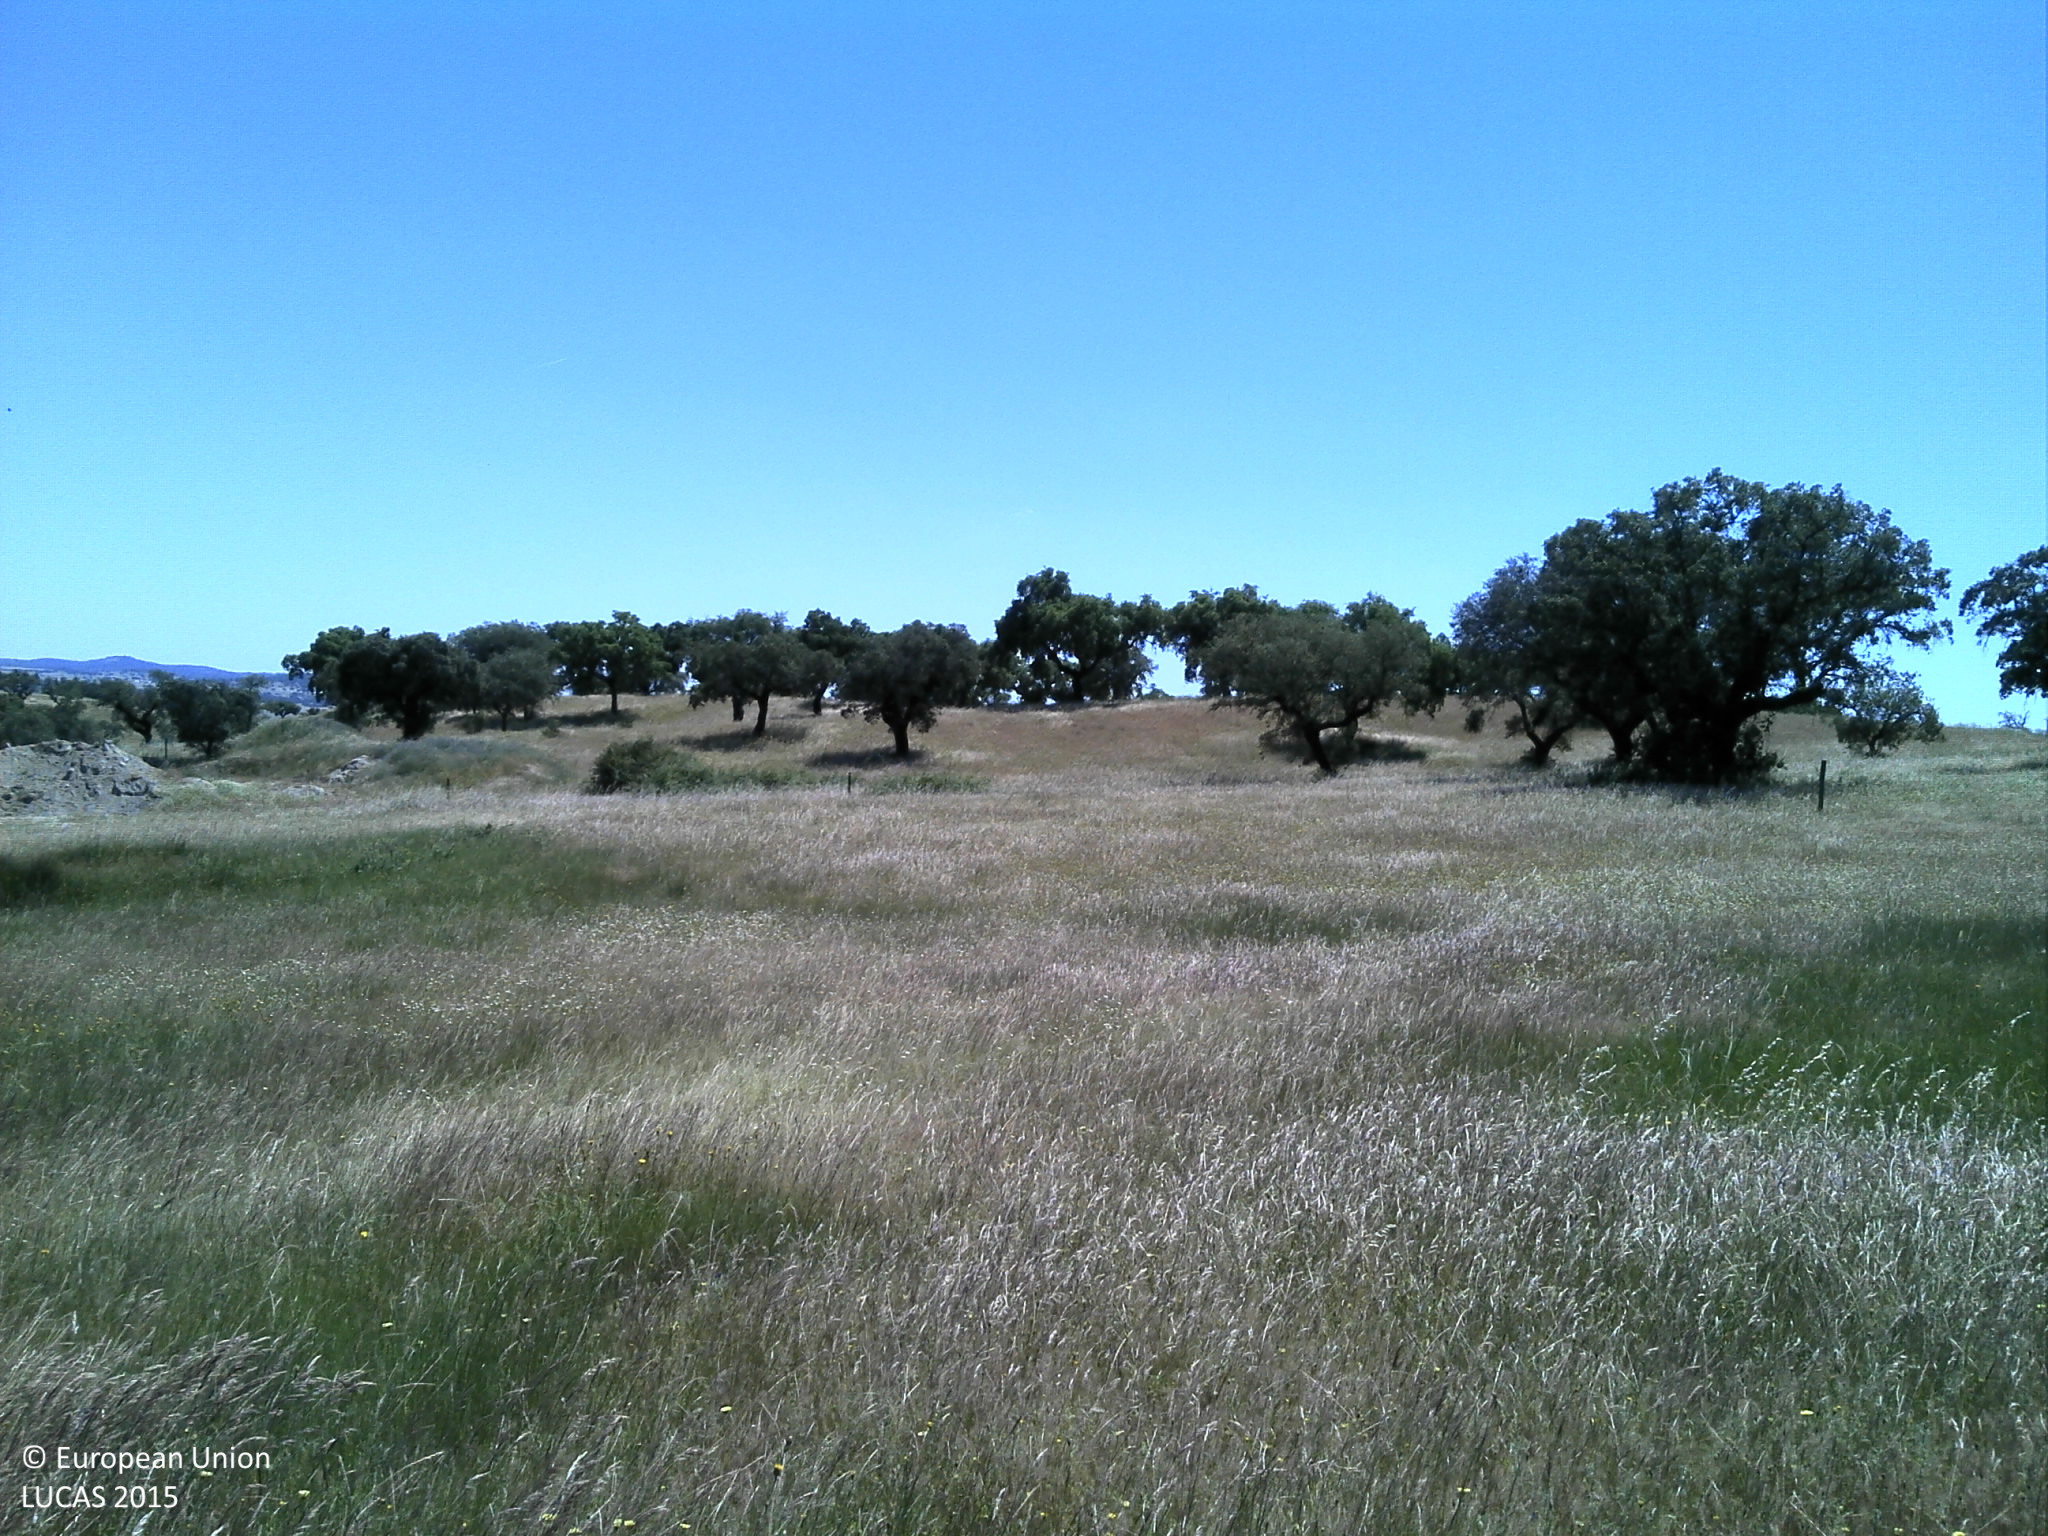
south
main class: Grassland
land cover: Grassland without tree/shrub cover
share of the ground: 50 - 75 %
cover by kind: herbaceous plants 60 %, unconsolidated bare surface 40 %
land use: Agriculture (excluding fallow land and kitchen gardens)
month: May
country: PT
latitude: 39.2973
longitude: -7.6604
